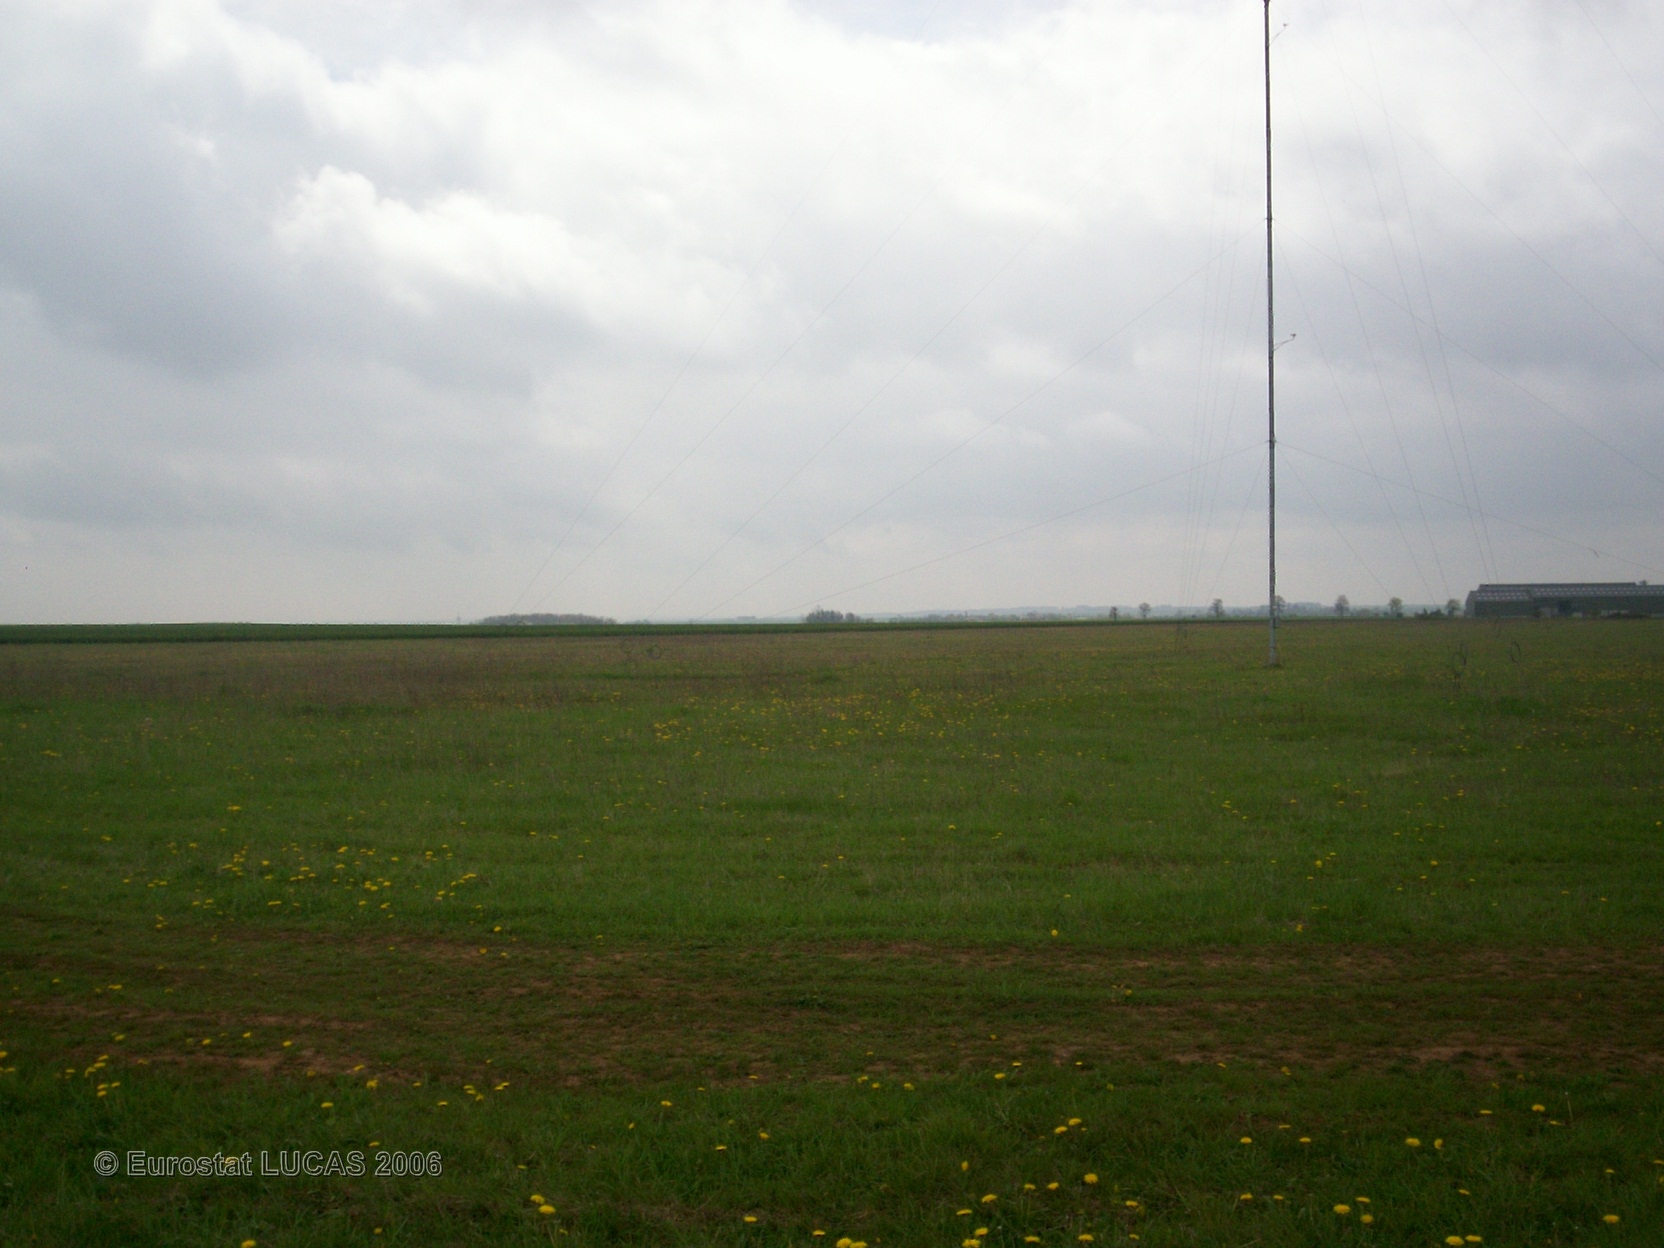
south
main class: Grassland
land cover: Grassland without tree/shrub cover
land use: Agriculture (excluding fallow land and kitchen gardens)
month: April
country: FR
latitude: 49.0573
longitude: -0.1729
